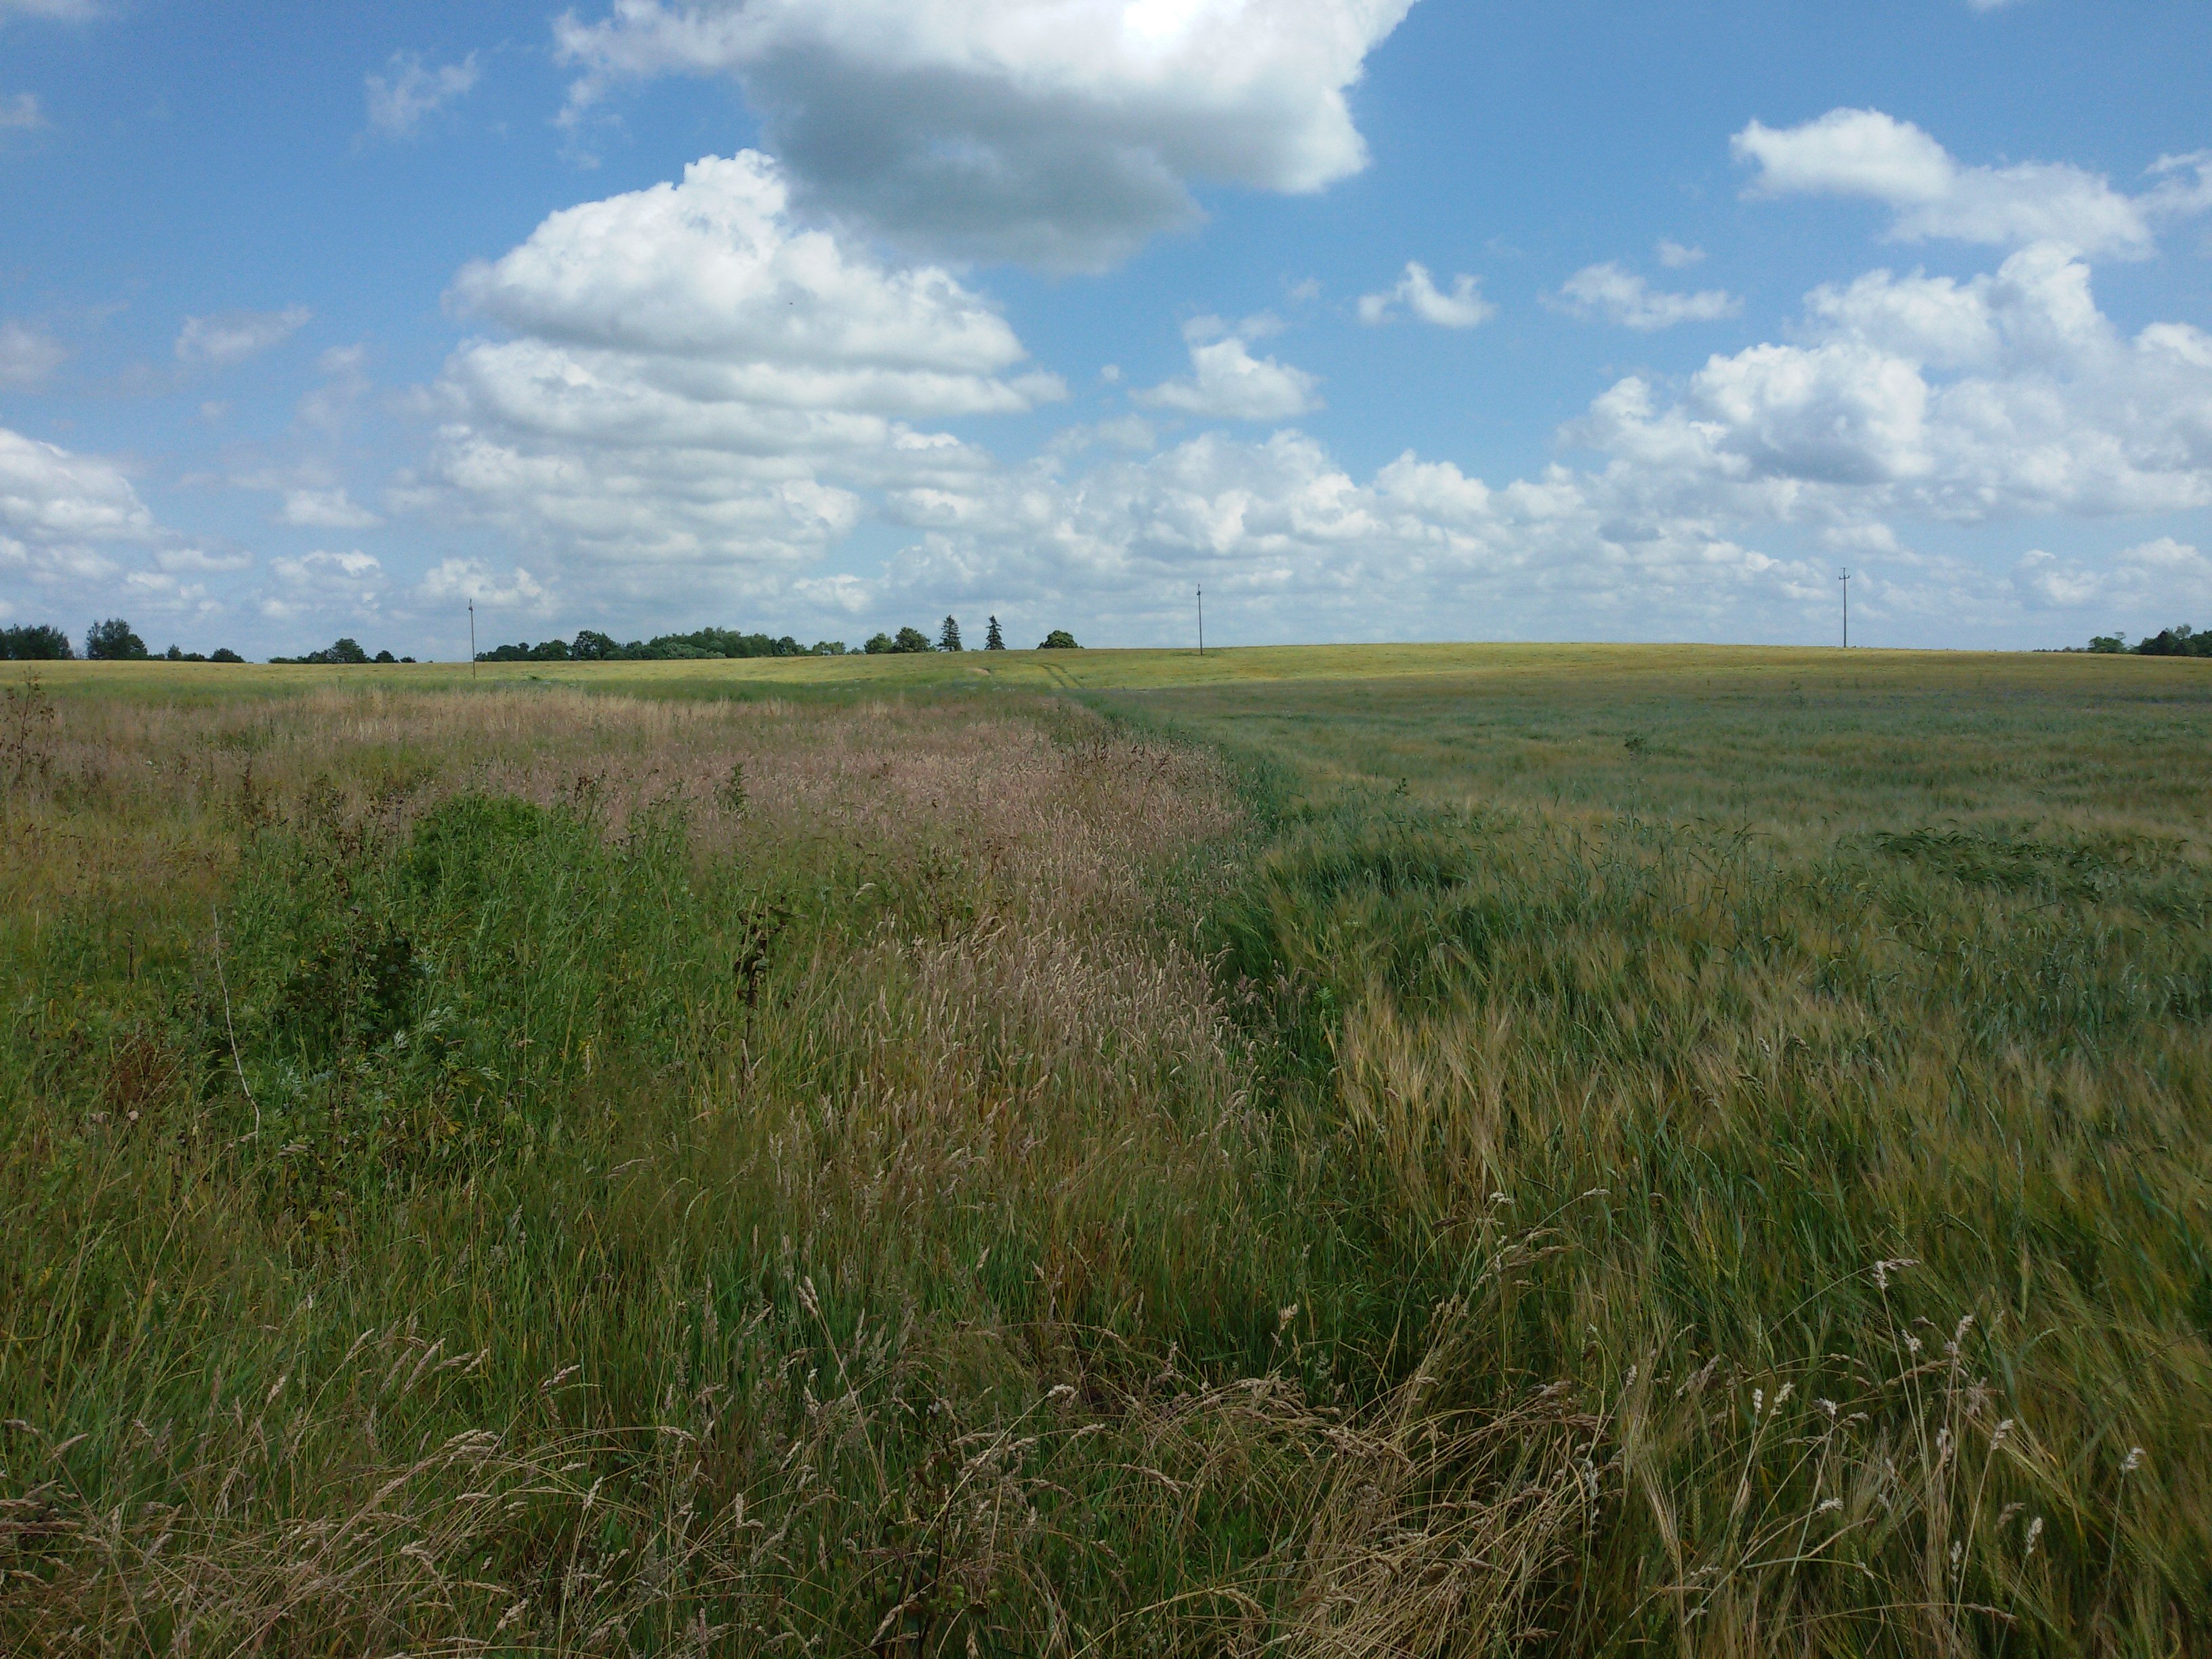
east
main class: Cropland
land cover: Barley
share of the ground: > 75 %
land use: Agriculture (excluding fallow land and kitchen gardens)
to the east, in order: Barley
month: July
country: PL
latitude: 54.1594
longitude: 15.8999
